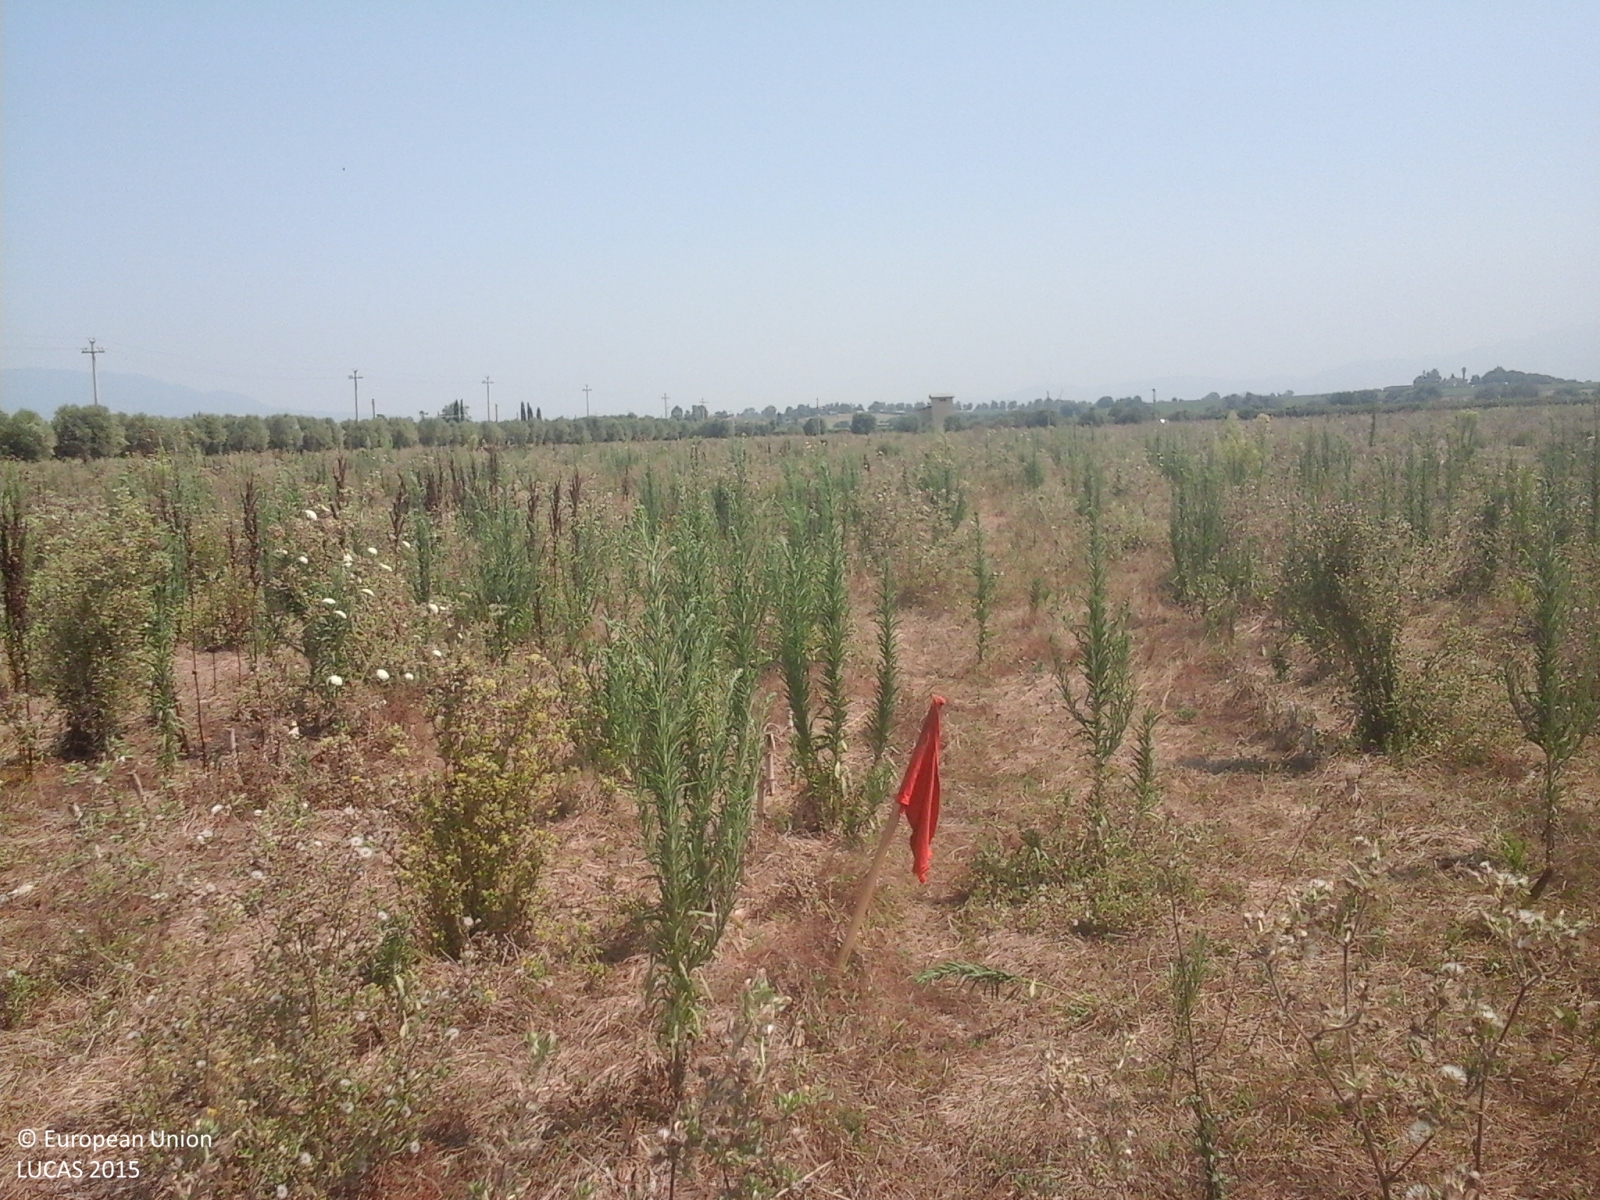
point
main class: Grassland
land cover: Grassland without tree/shrub cover
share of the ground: > 75 %
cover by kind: herbaceous plants 100 %
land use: Agriculture (excluding fallow land and kitchen gardens)
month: July
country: IT
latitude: 41.5866
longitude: 12.7362
